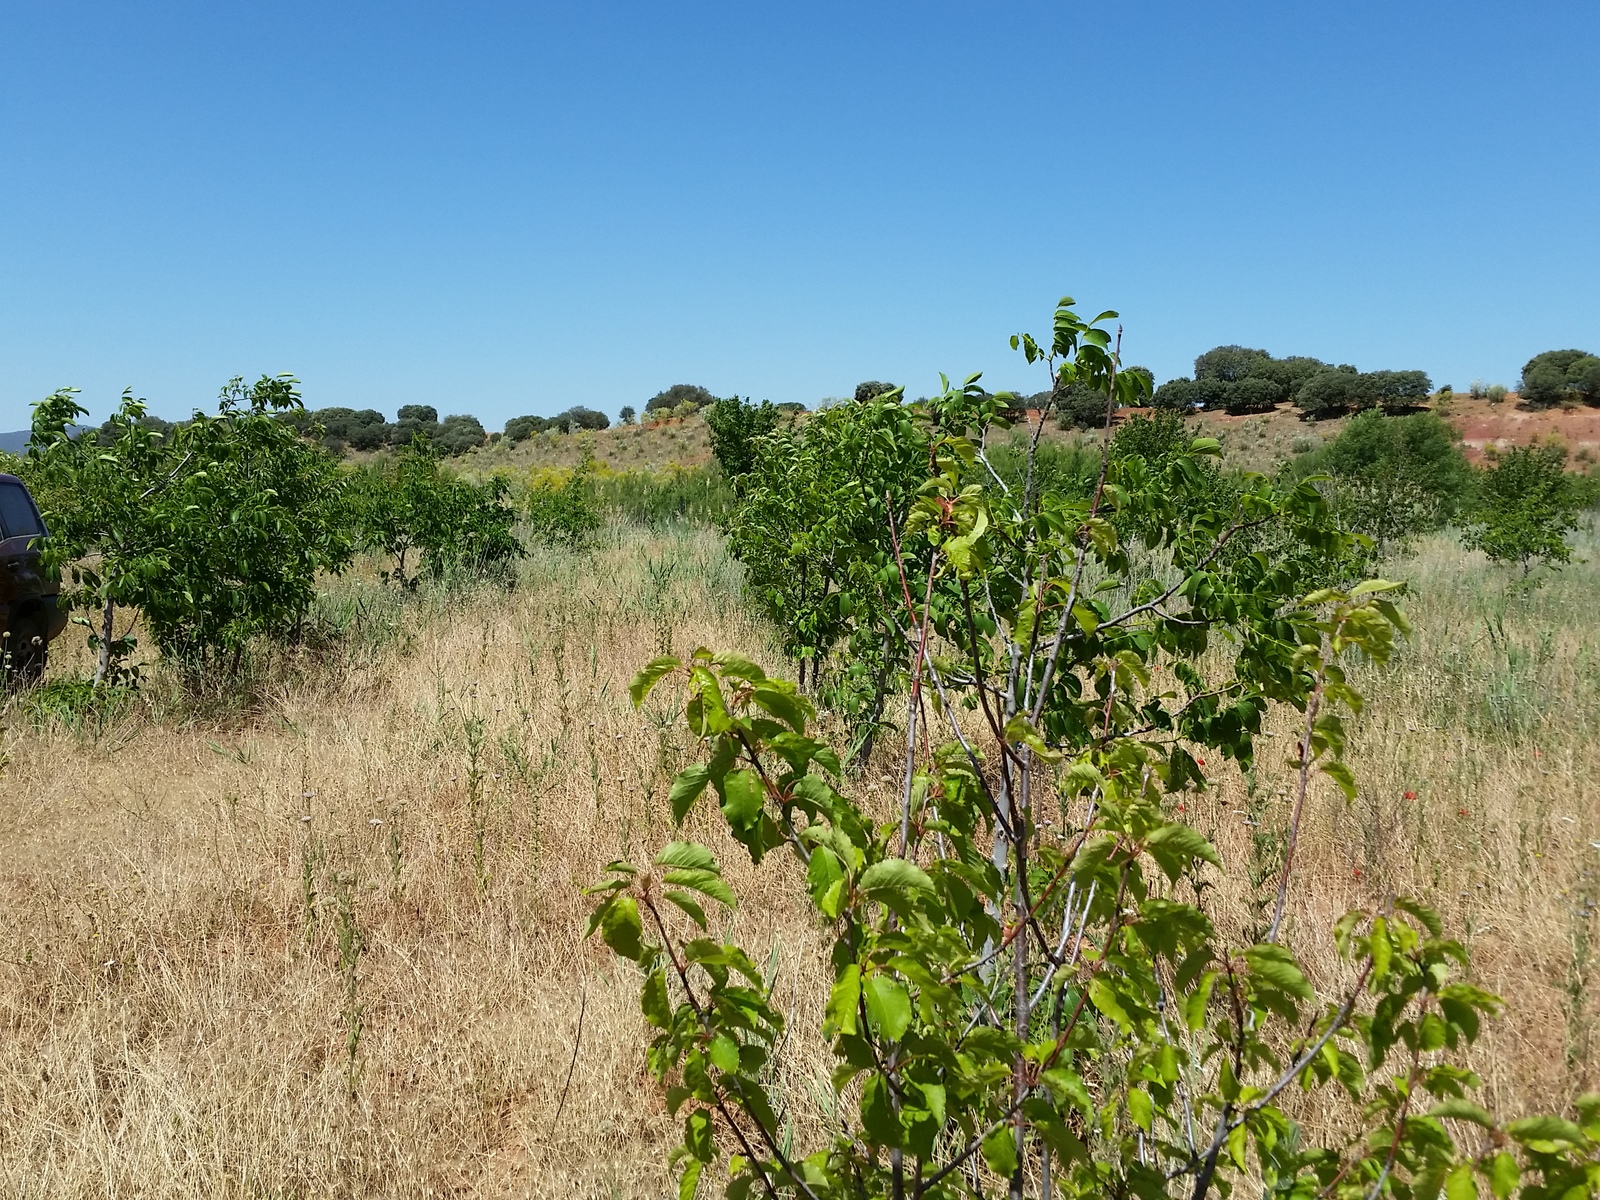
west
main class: Cropland
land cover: Nuts trees
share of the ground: 25 - 50 %
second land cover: Grassland without tree/shrub cover
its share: > 75 %
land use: Agriculture (excluding fallow land and kitchen gardens)
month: June
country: ES
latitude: 38.6694
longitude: -2.5641
